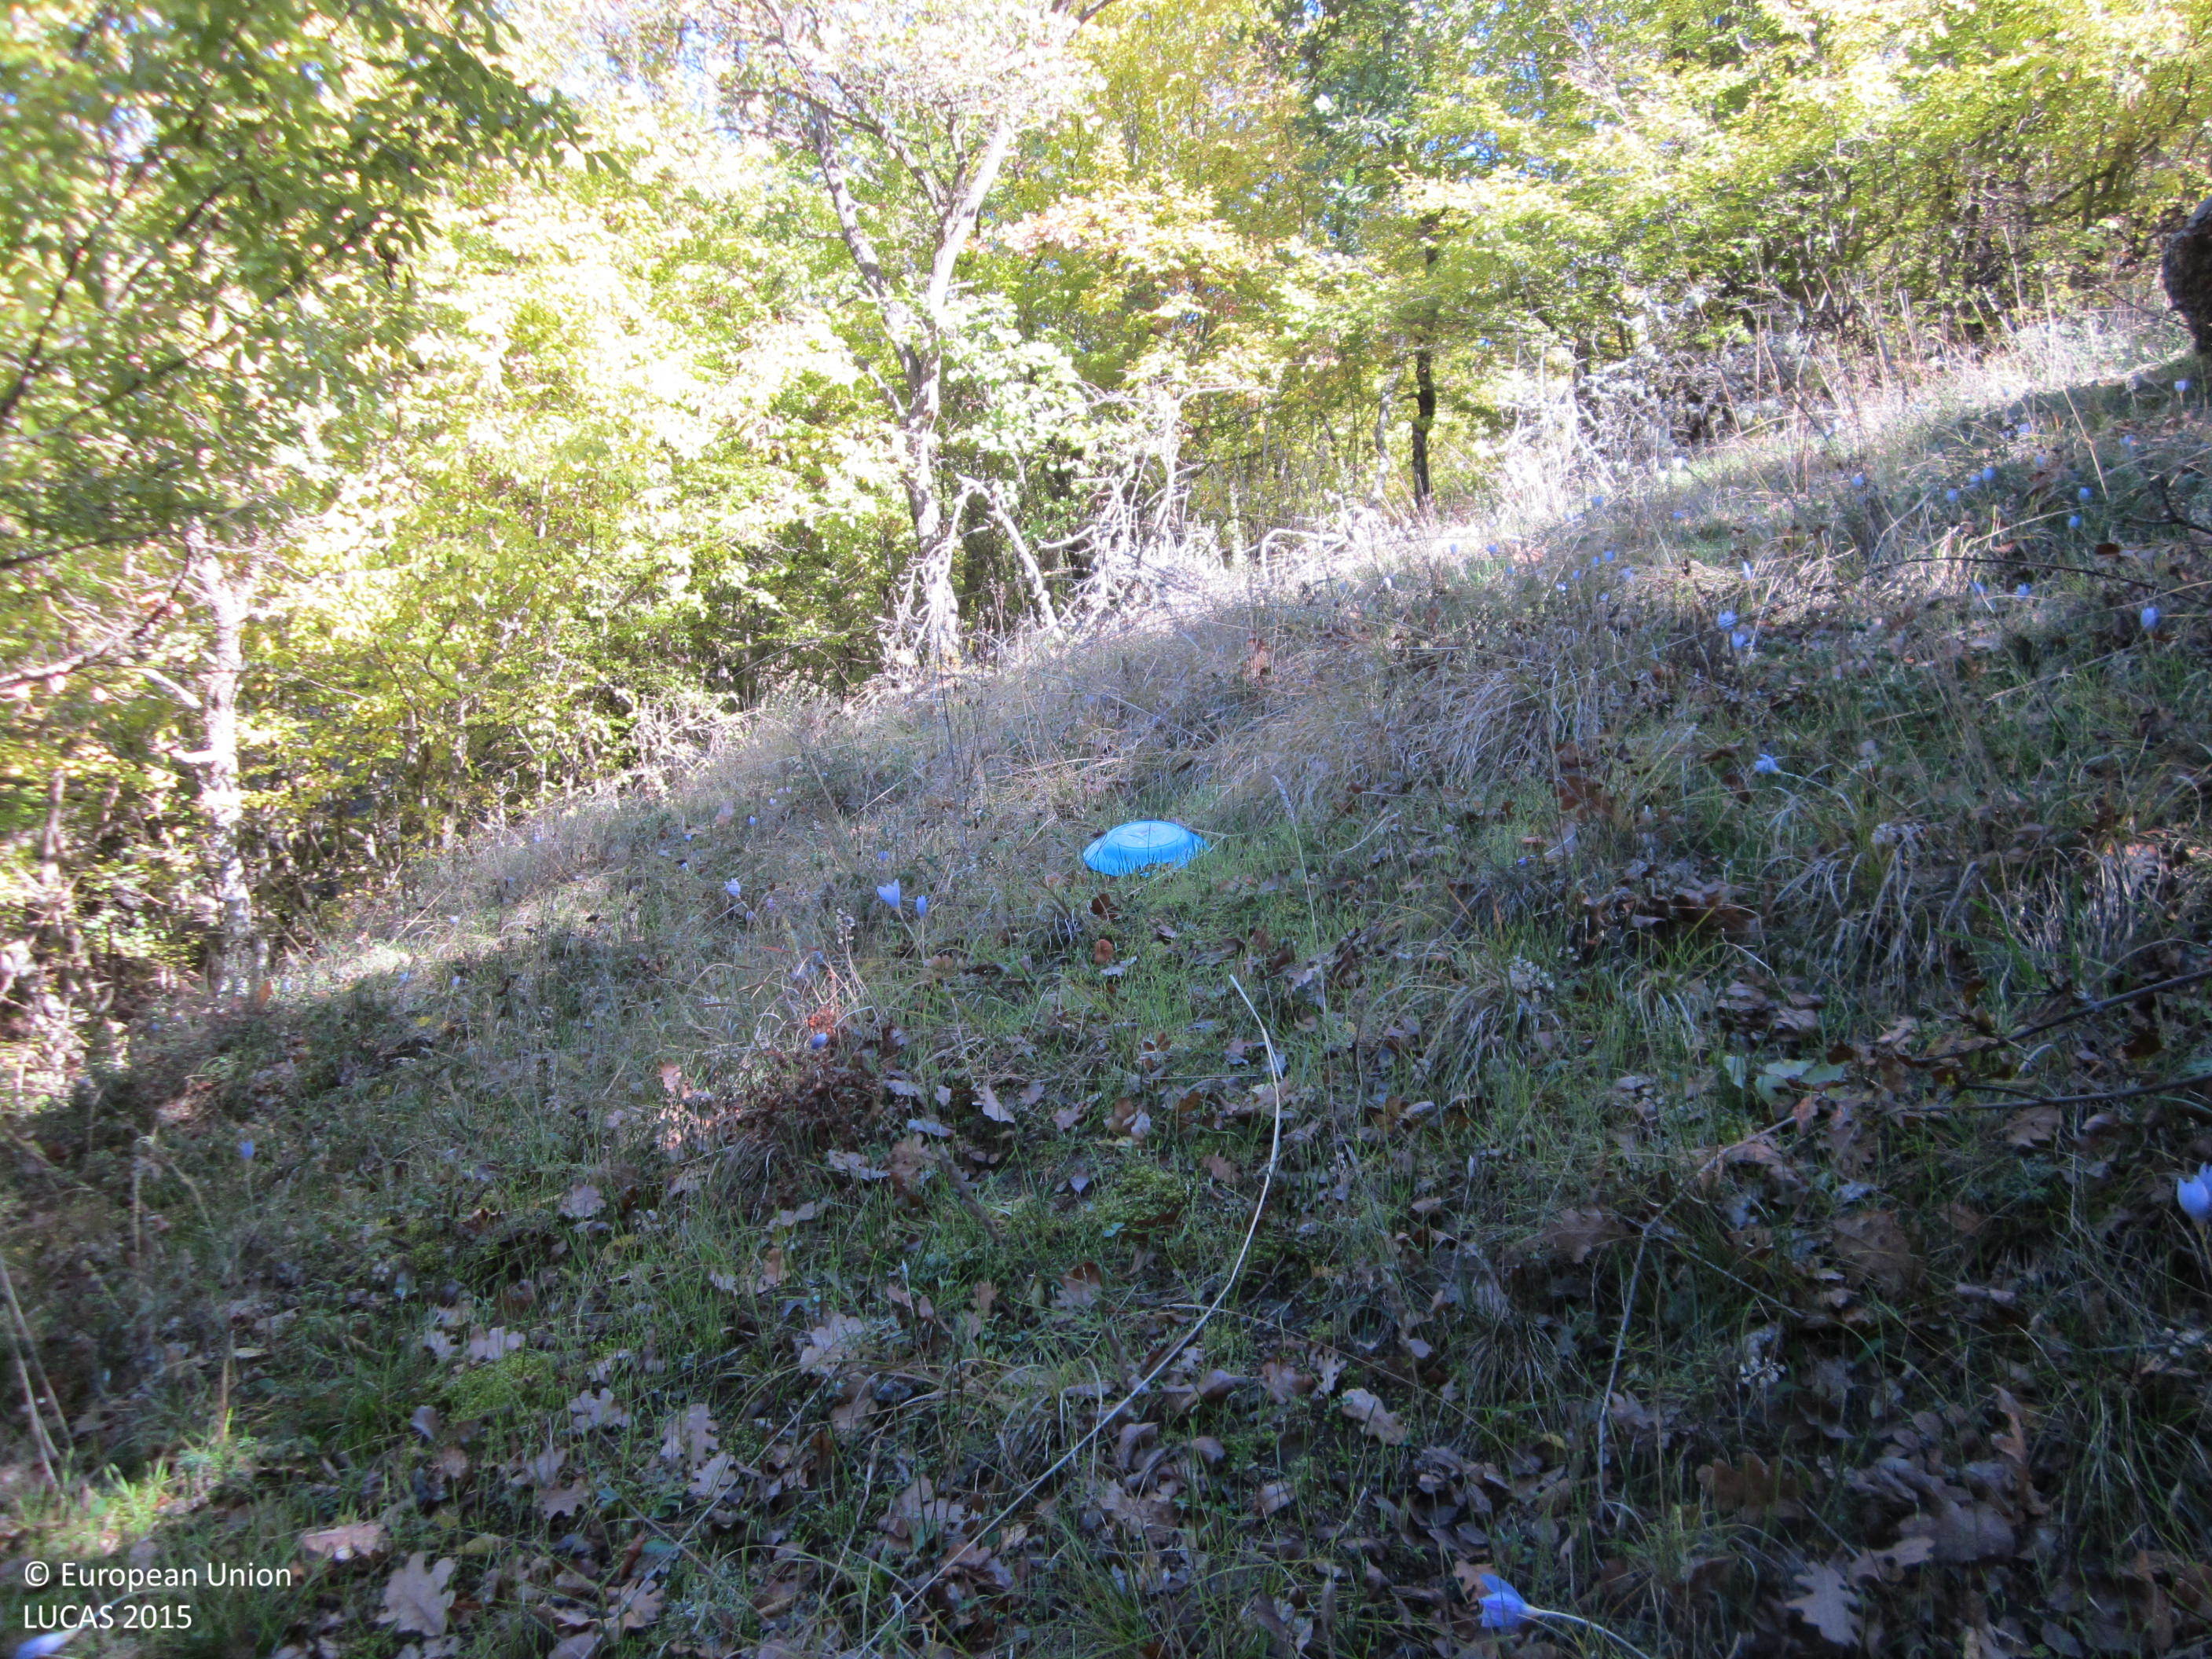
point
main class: Woodland
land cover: Broadleaved woodland
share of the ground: > 75 %
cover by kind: broadleaved forest trees 80 %, herbaceous plants 15 %, shrubs 5 %
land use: Forestry
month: November
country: BG
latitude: 41.4589
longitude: 25.8062
